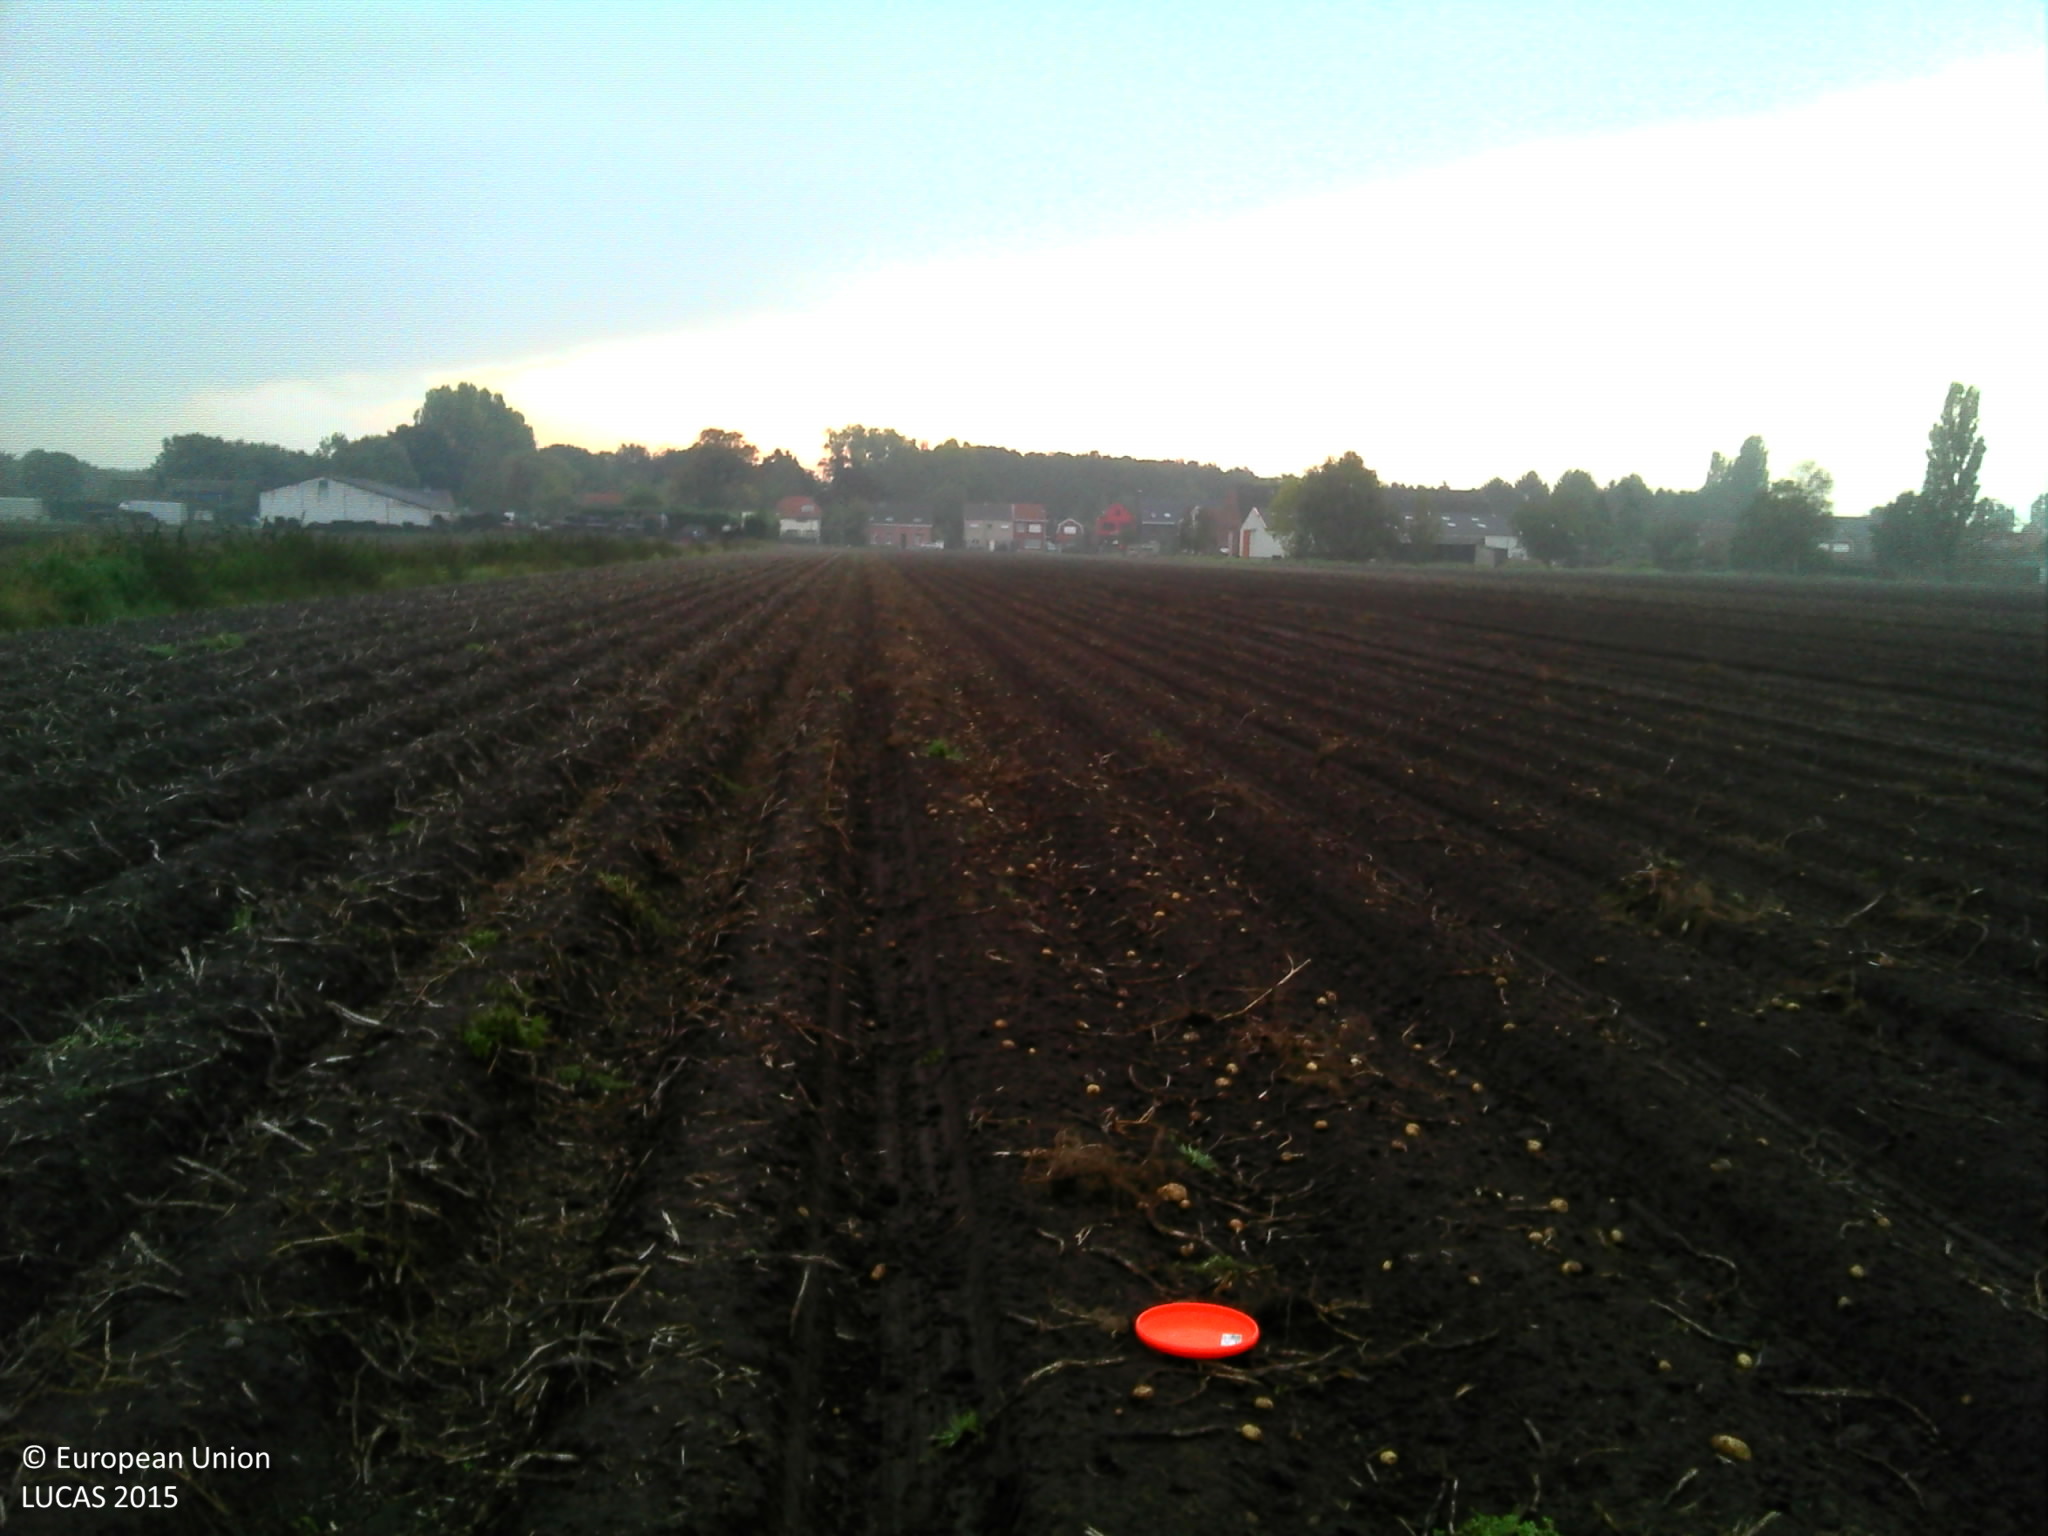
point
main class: Cropland
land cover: Potatoes
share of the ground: 10 - 25 %
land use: Agriculture (excluding fallow land and kitchen gardens)
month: October
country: BE
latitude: 51.3435
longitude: 4.3821
